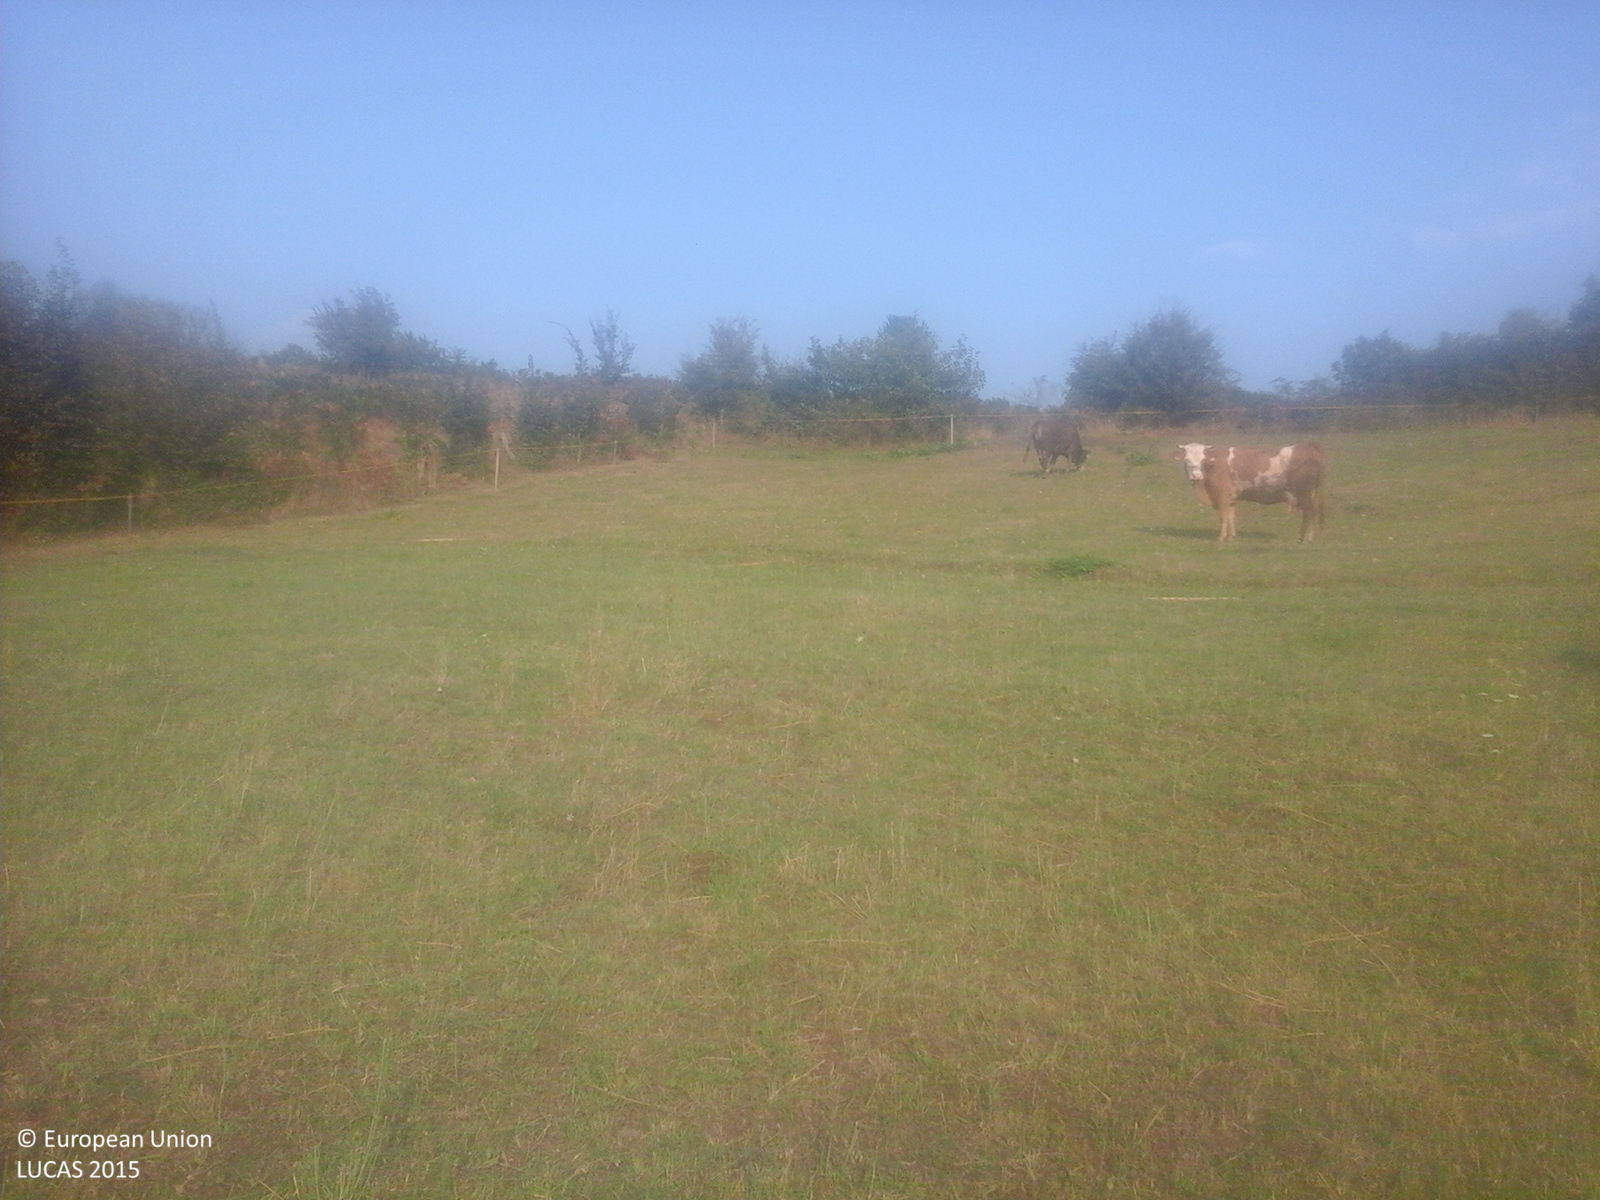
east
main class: Grassland
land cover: Grassland without tree/shrub cover
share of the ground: > 75 %
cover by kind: herbaceous plants 100 %
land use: Agriculture (excluding fallow land and kitchen gardens)
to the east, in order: Grassland without tree/shrub cover; Fences; Abandoned hedges; Spontaneously vegetated surfaces; Grassland without tree/shrub cover; Spontaneously vegetated surfaces; Tracks; Grassland without tree/shrub cover
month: September
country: RO
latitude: 47.5891
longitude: 23.7896
